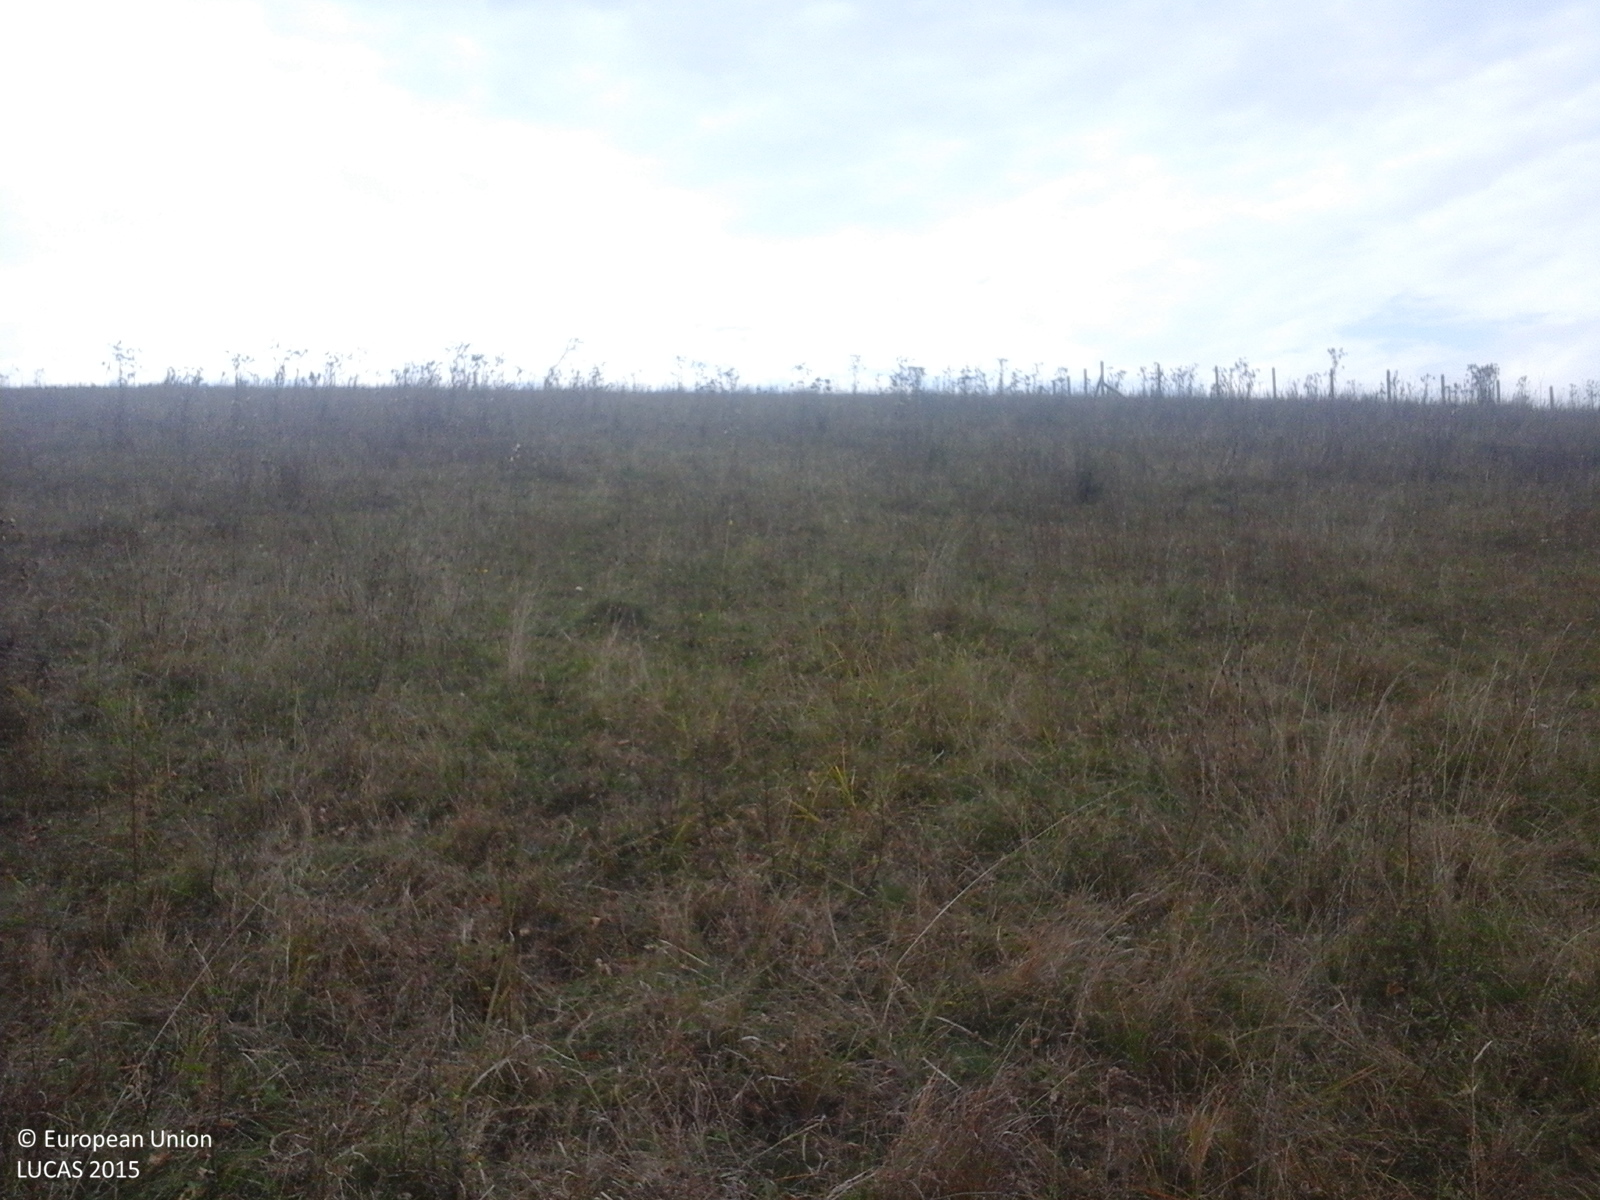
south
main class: Grassland
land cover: Grassland without tree/shrub cover
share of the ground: > 75 %
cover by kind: herbaceous plants 100 %
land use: Agriculture (excluding fallow land and kitchen gardens)
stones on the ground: < 10 %
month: October
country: RO
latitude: 46.1660
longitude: 25.3728
